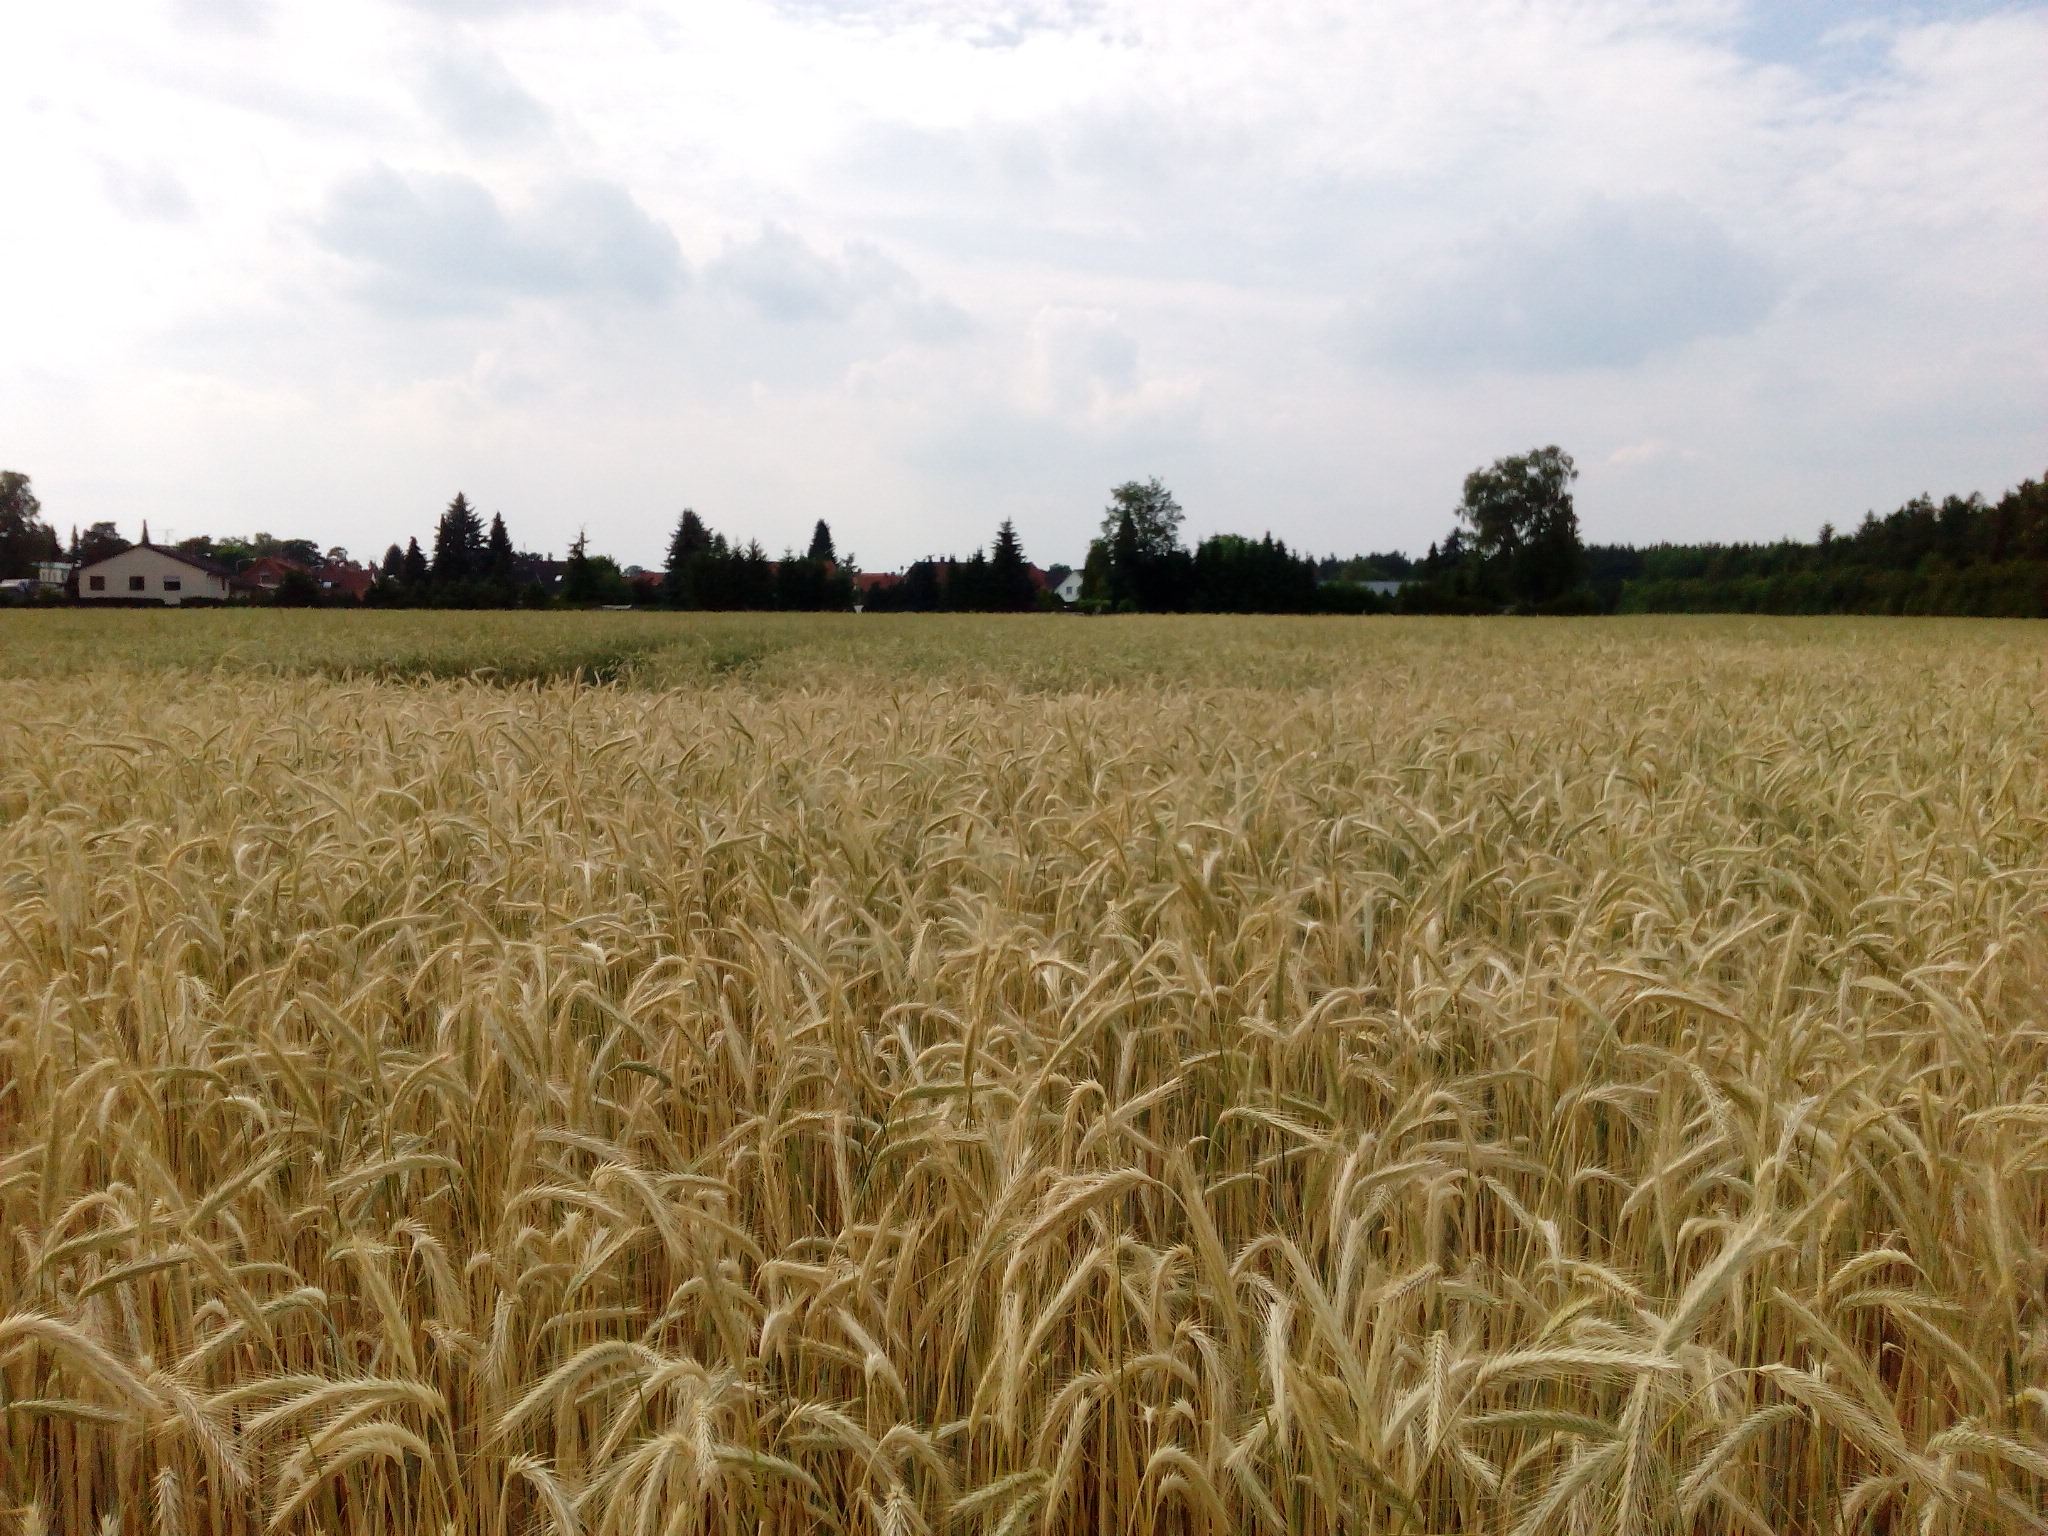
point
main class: Cropland
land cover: Rye
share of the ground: > 75 %
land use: Agriculture (excluding fallow land and kitchen gardens)
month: June
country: DE
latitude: 52.6470
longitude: 9.8670
